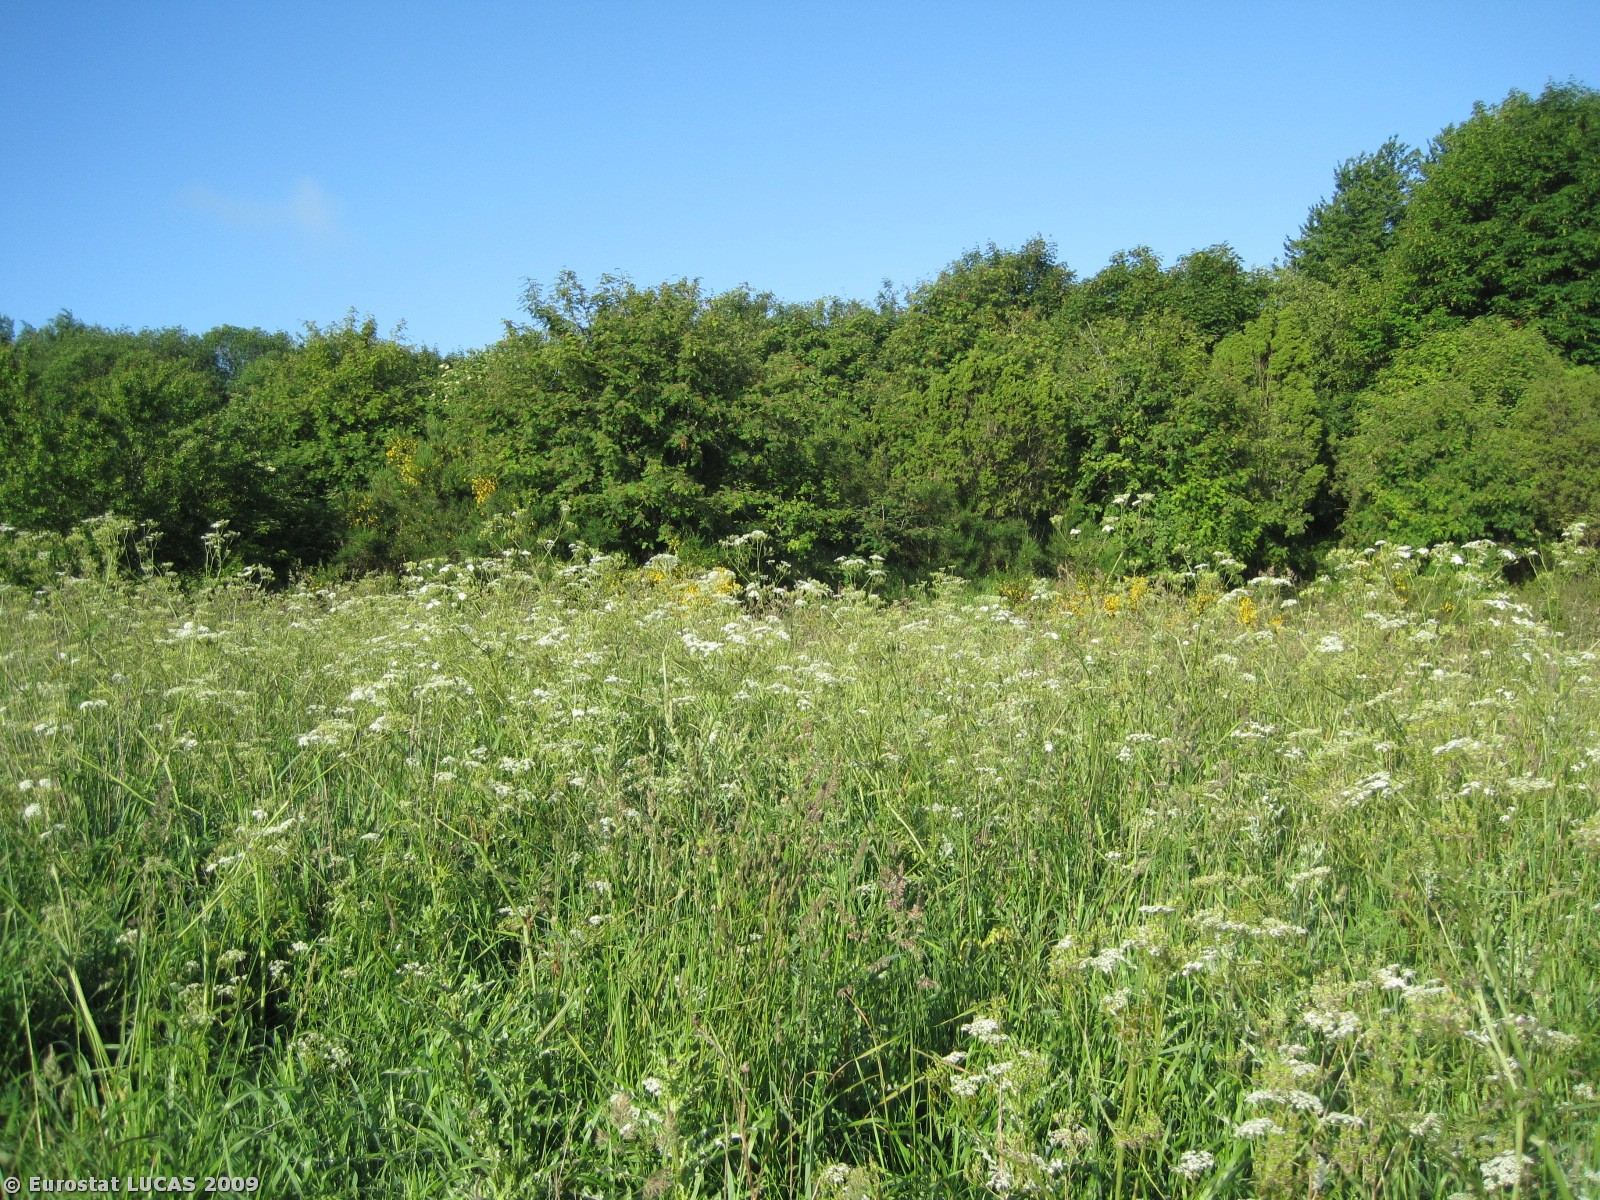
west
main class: Grassland
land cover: Grassland without tree/shrub cover
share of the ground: > 75 %
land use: Unused
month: June
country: DK
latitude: 57.2302
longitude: 10.2481
